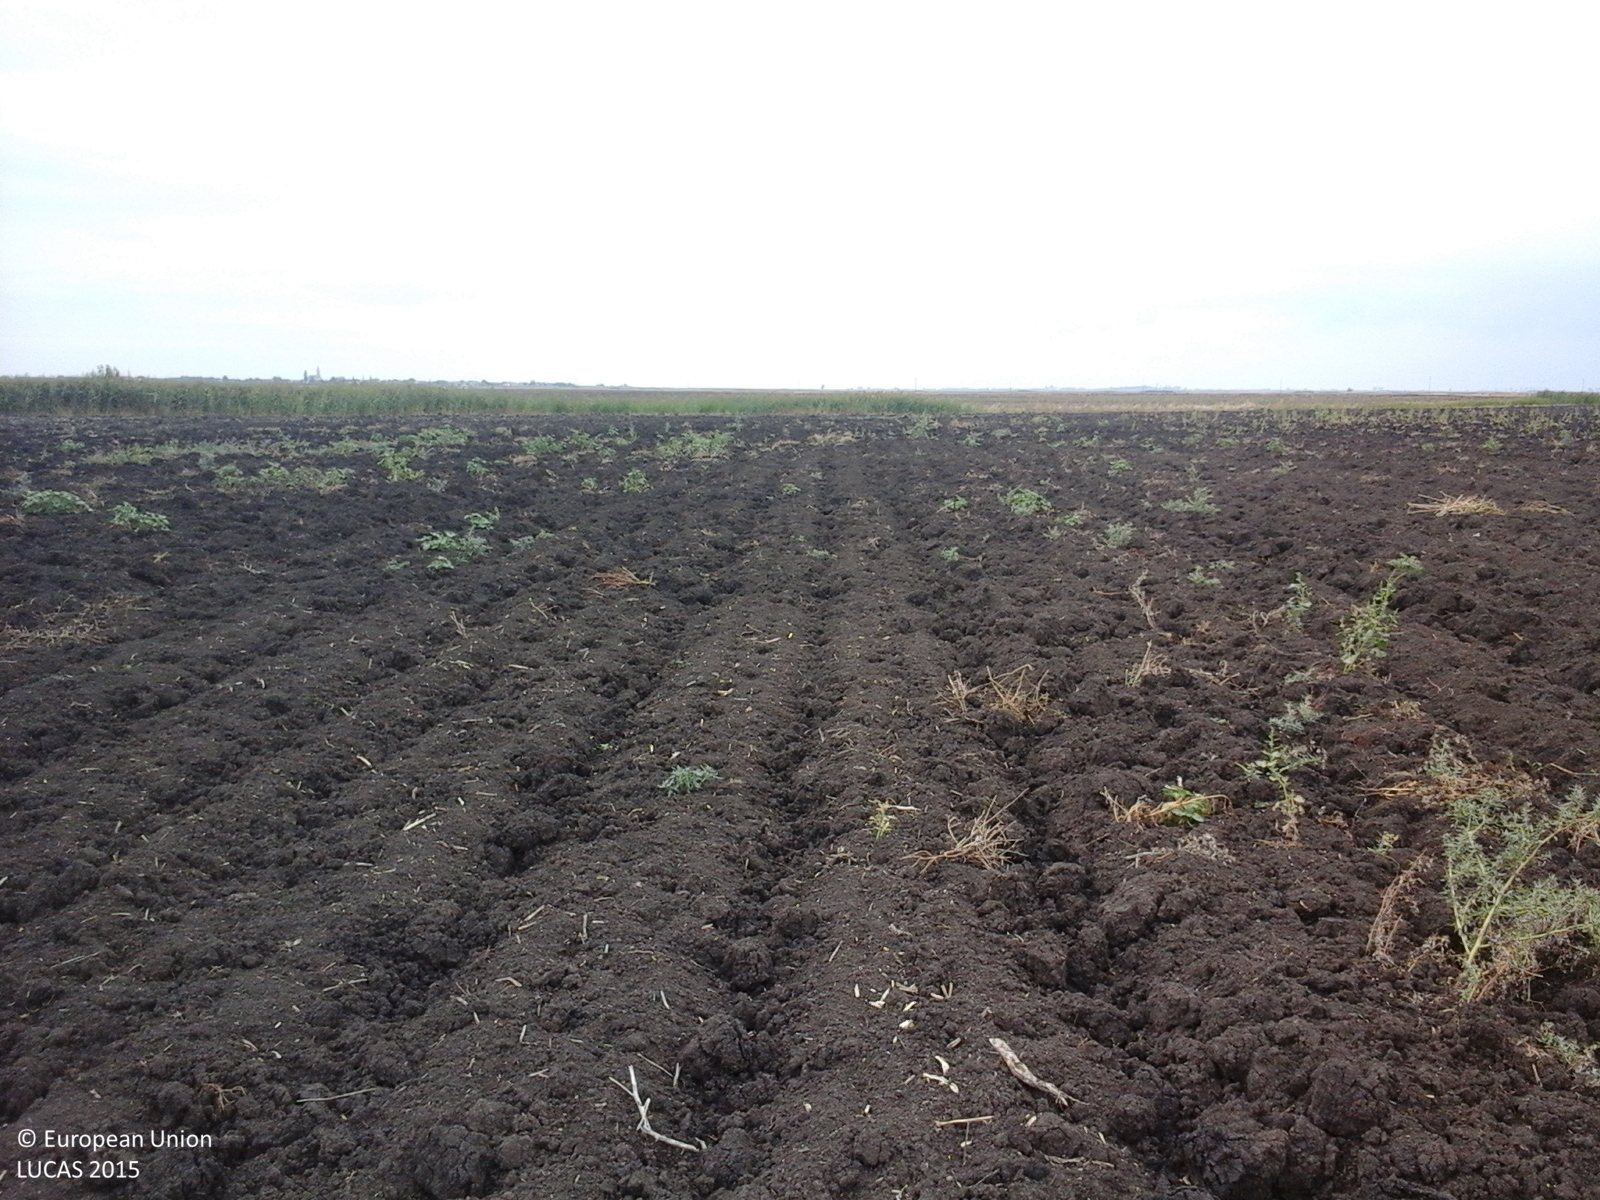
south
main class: Cropland
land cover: Rape and turnip rape
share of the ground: < 10 %
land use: Agriculture (excluding fallow land and kitchen gardens)
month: August
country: RO
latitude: 45.9918
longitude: 20.5466
